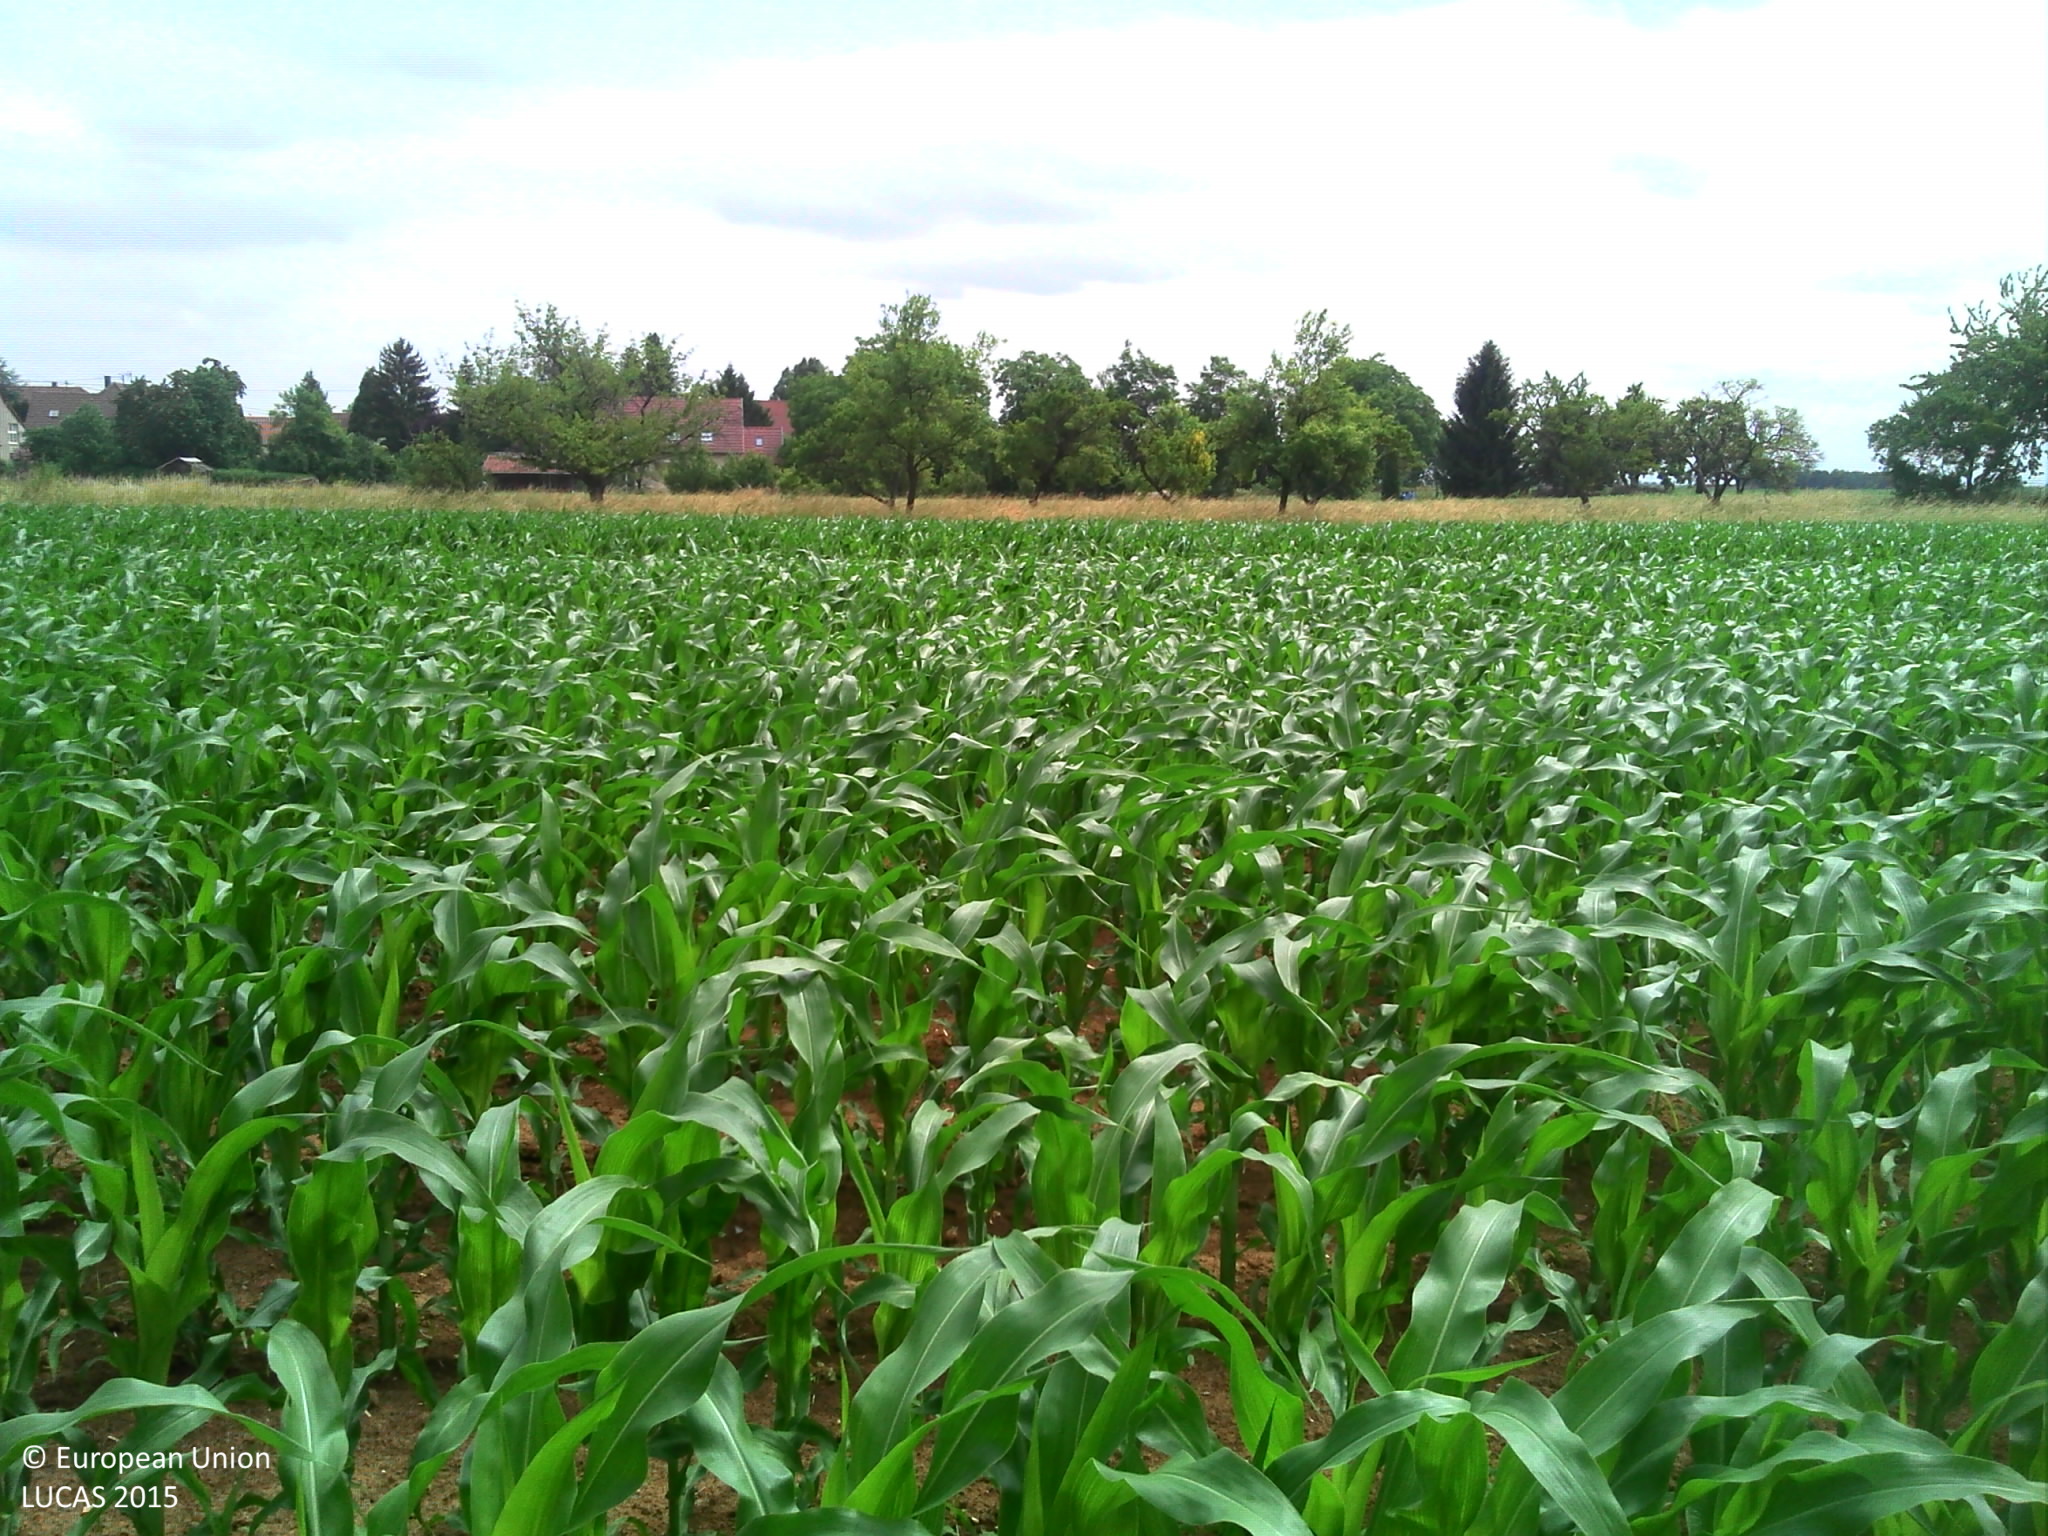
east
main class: Cropland
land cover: Maize
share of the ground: 50 - 75 %
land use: Agriculture (excluding fallow land and kitchen gardens)
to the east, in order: Maize; Apple fruit; Grassland without tree/shrub cover; Cherry fruit; Common wheat; Maize; Fences; Apple fruit; Fences; Grassland without tree/shrub cover; Fences; Broadleaved woodland; Artificial constructions in urban areas; Grass margins; Maize; Broadleaved woodland; Fences; Grassland with sparse tree/shrub cover; Artificial constructions in urban areas; Common wheat; Grass margins; Tracks; Grass margins; Potatoes
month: June
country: FR
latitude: 48.5198
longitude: 7.5232
